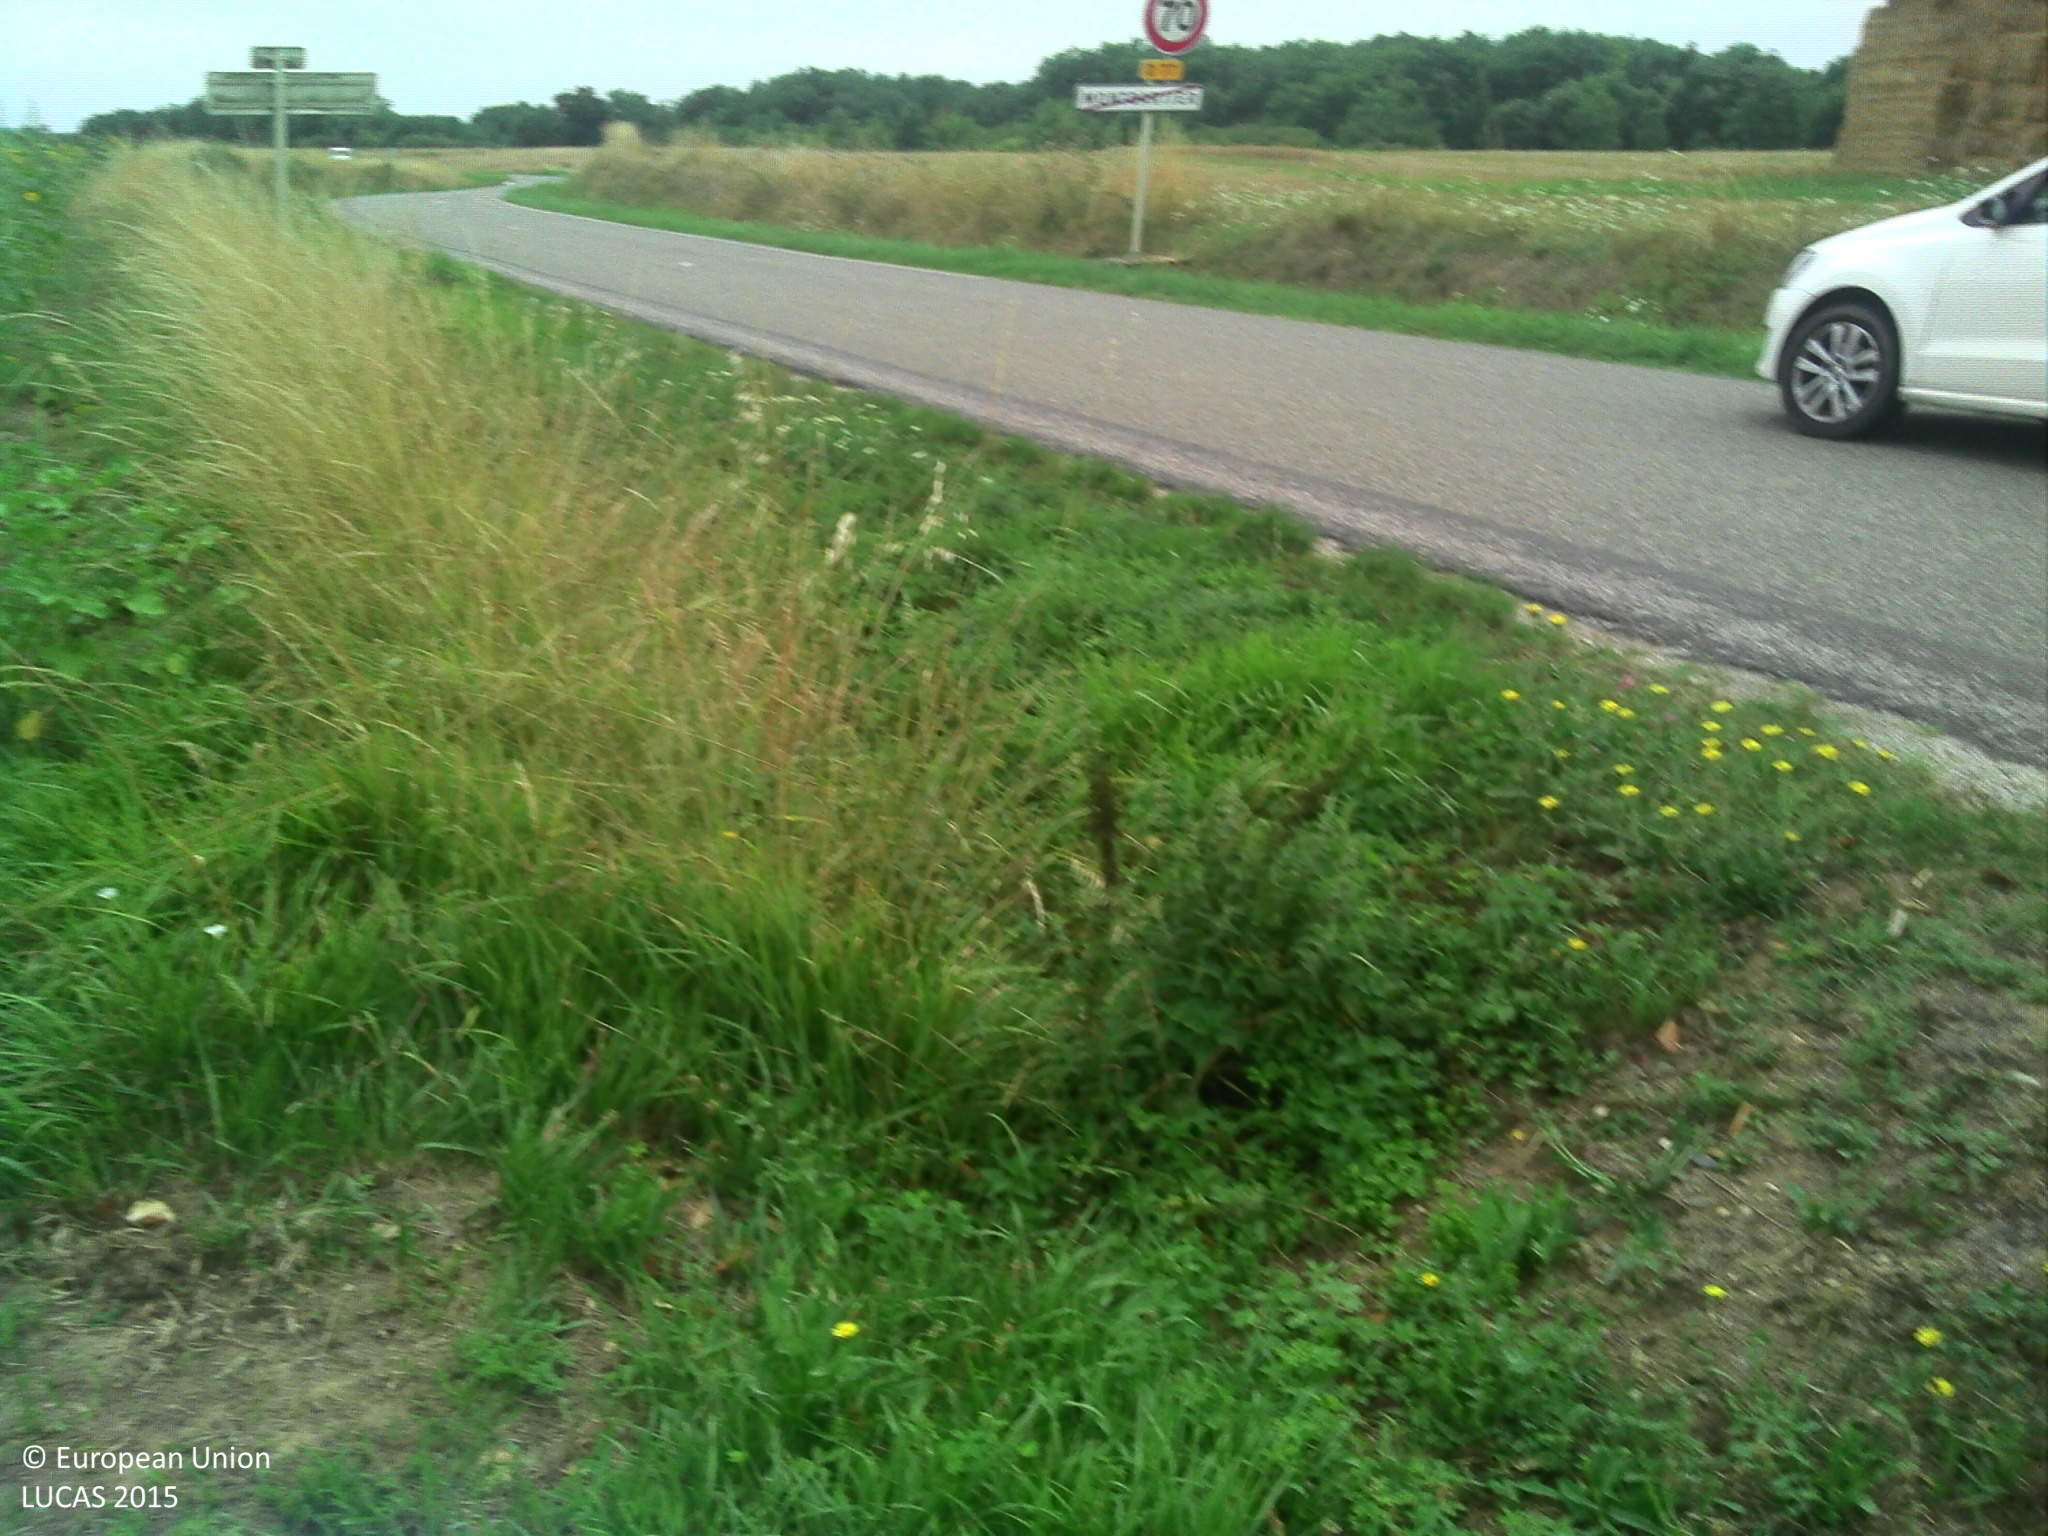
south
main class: Grassland
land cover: Grassland with sparse tree/shrub cover
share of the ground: > 75 %
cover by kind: herbaceous plants 95 %, broadleaved forest trees 5 %
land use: Residential
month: August
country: FR
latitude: 43.9096
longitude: 1.2712
